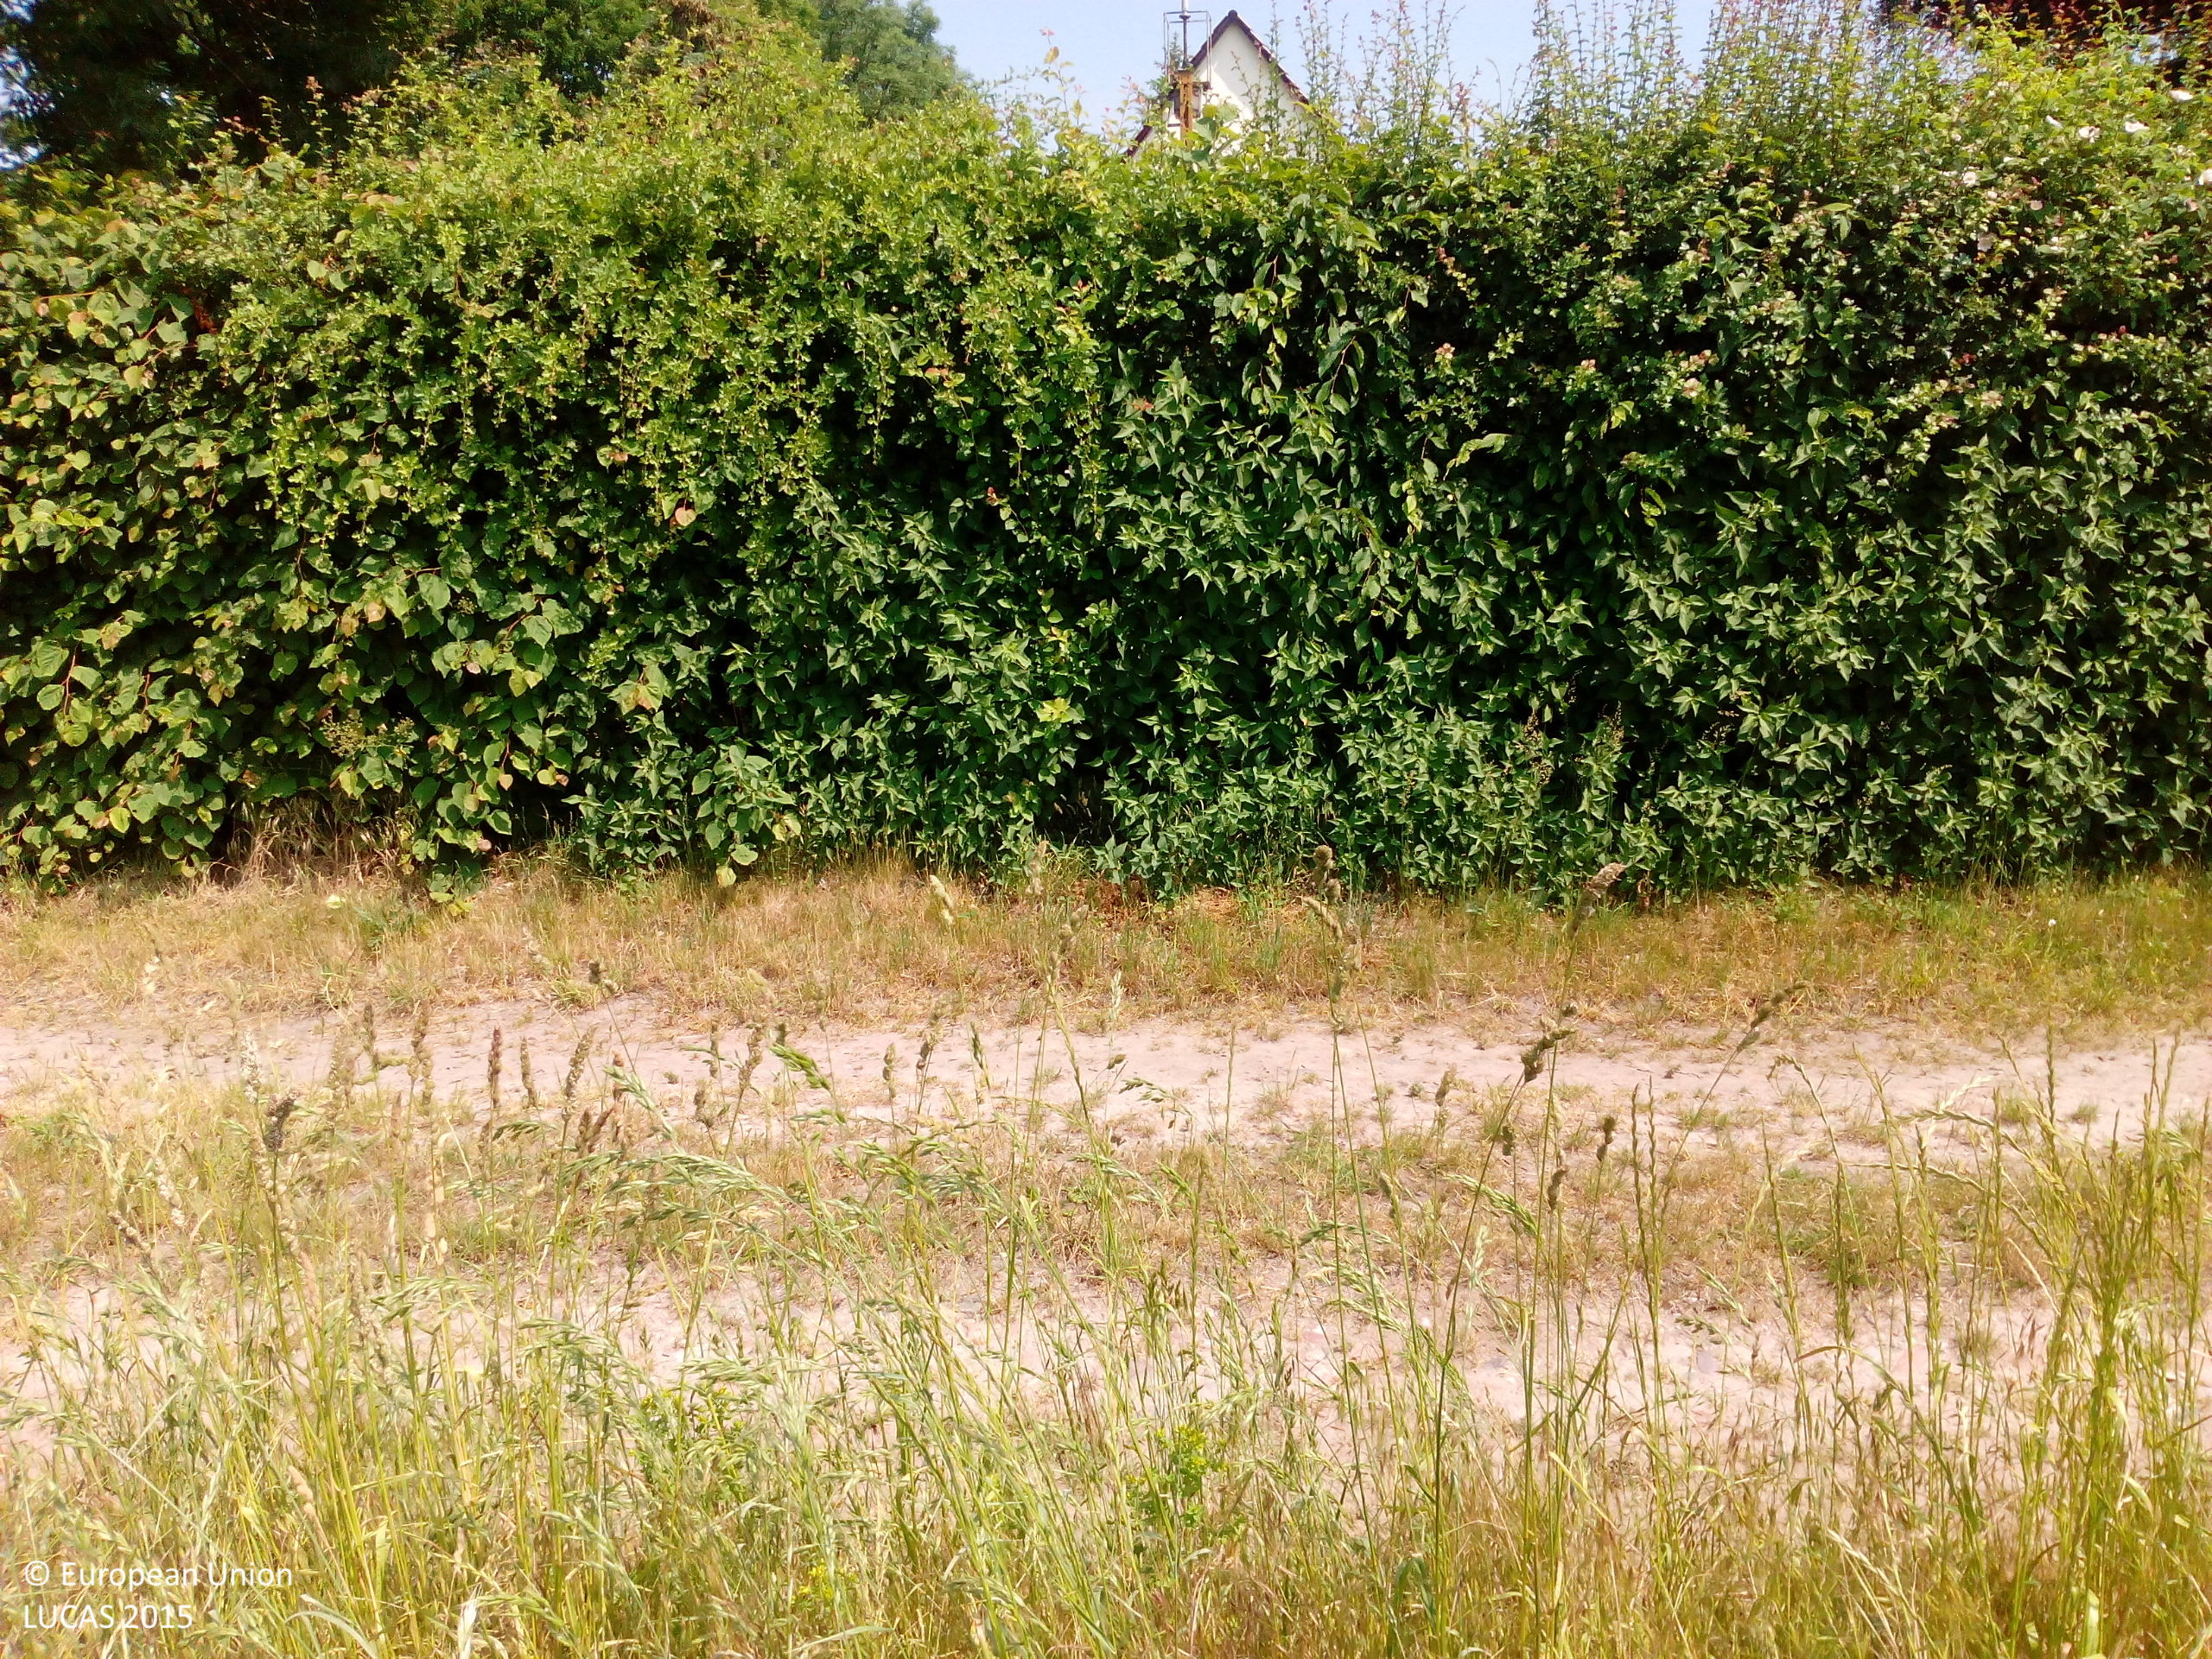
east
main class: Cropland
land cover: Dry pulses
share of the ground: > 75 %
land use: Agriculture (excluding fallow land and kitchen gardens)
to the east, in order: Dry pulses; Artificial constructions in urban areas
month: June
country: DE
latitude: 51.4330
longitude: 12.5458
